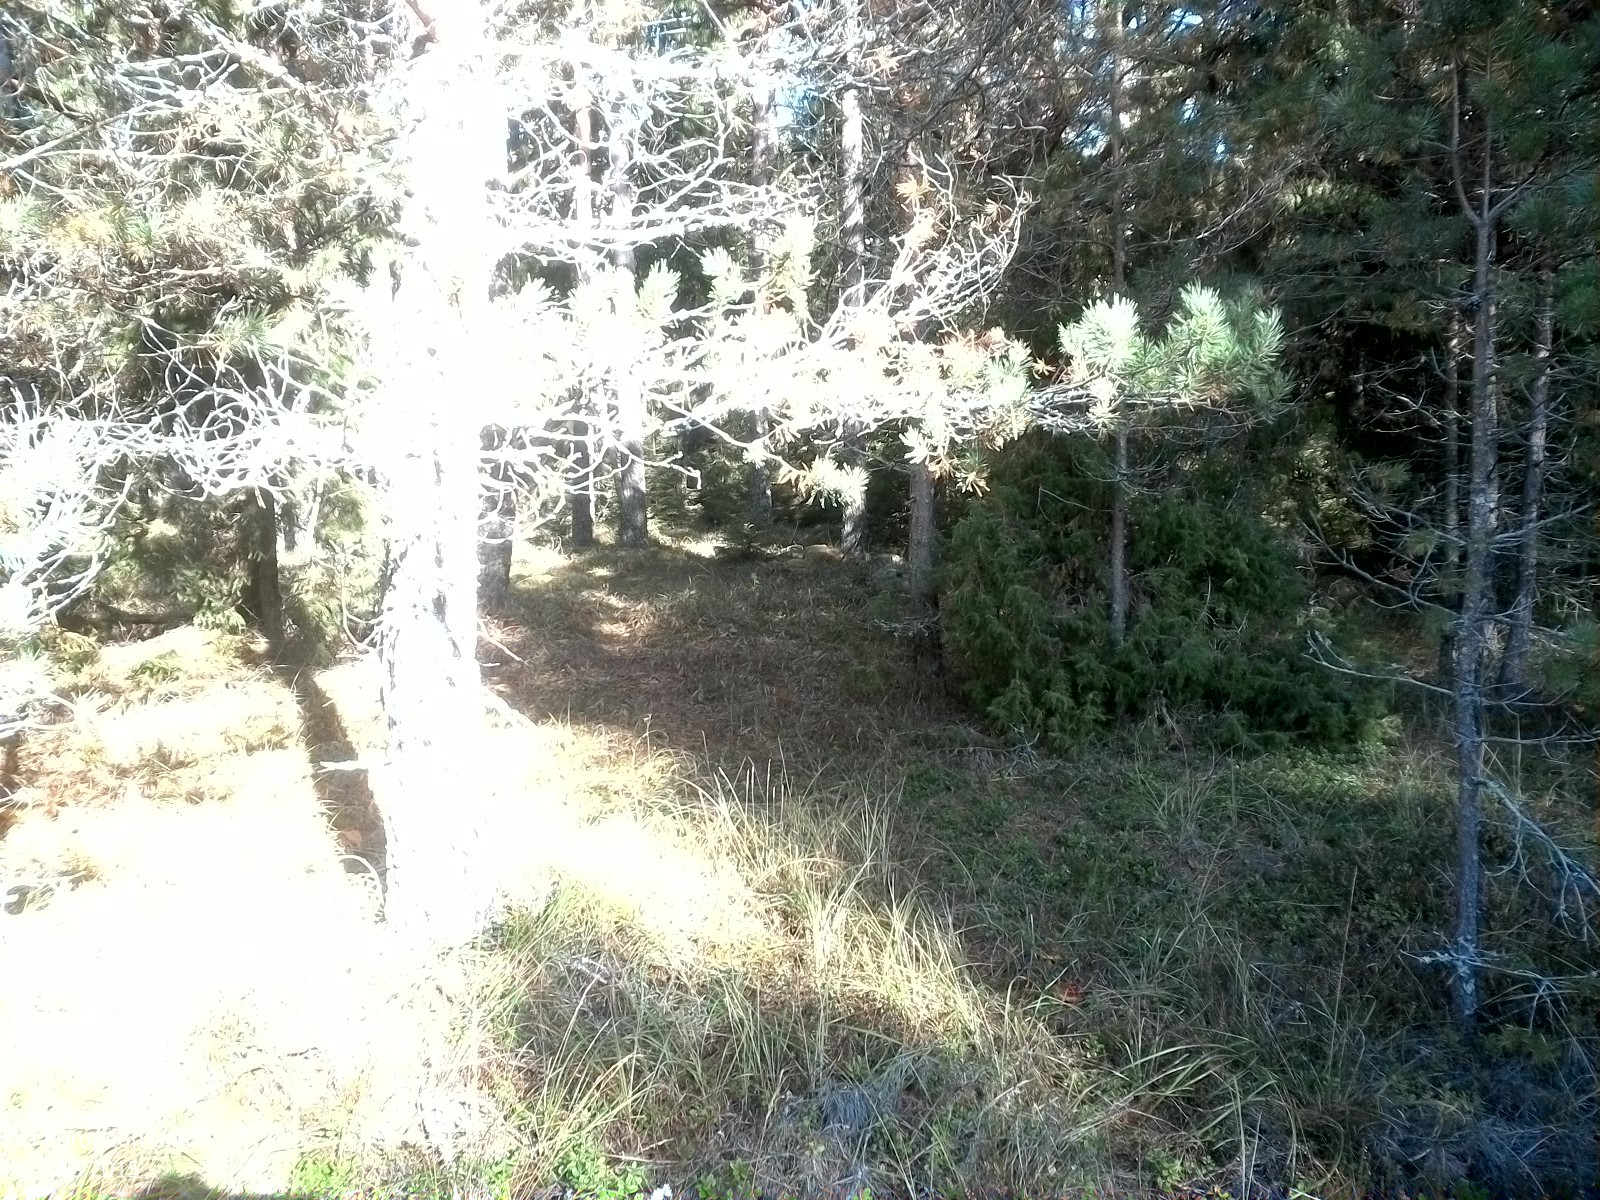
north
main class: Shrubland
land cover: Shrubland with sparse tree cover
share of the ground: > 75 %
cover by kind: shrubs 90 %, coniferous forest trees 5 %, herbaceous plants 5 %
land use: Forestry
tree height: < 5 m
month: September
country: SE
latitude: 58.7685
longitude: 16.8262
